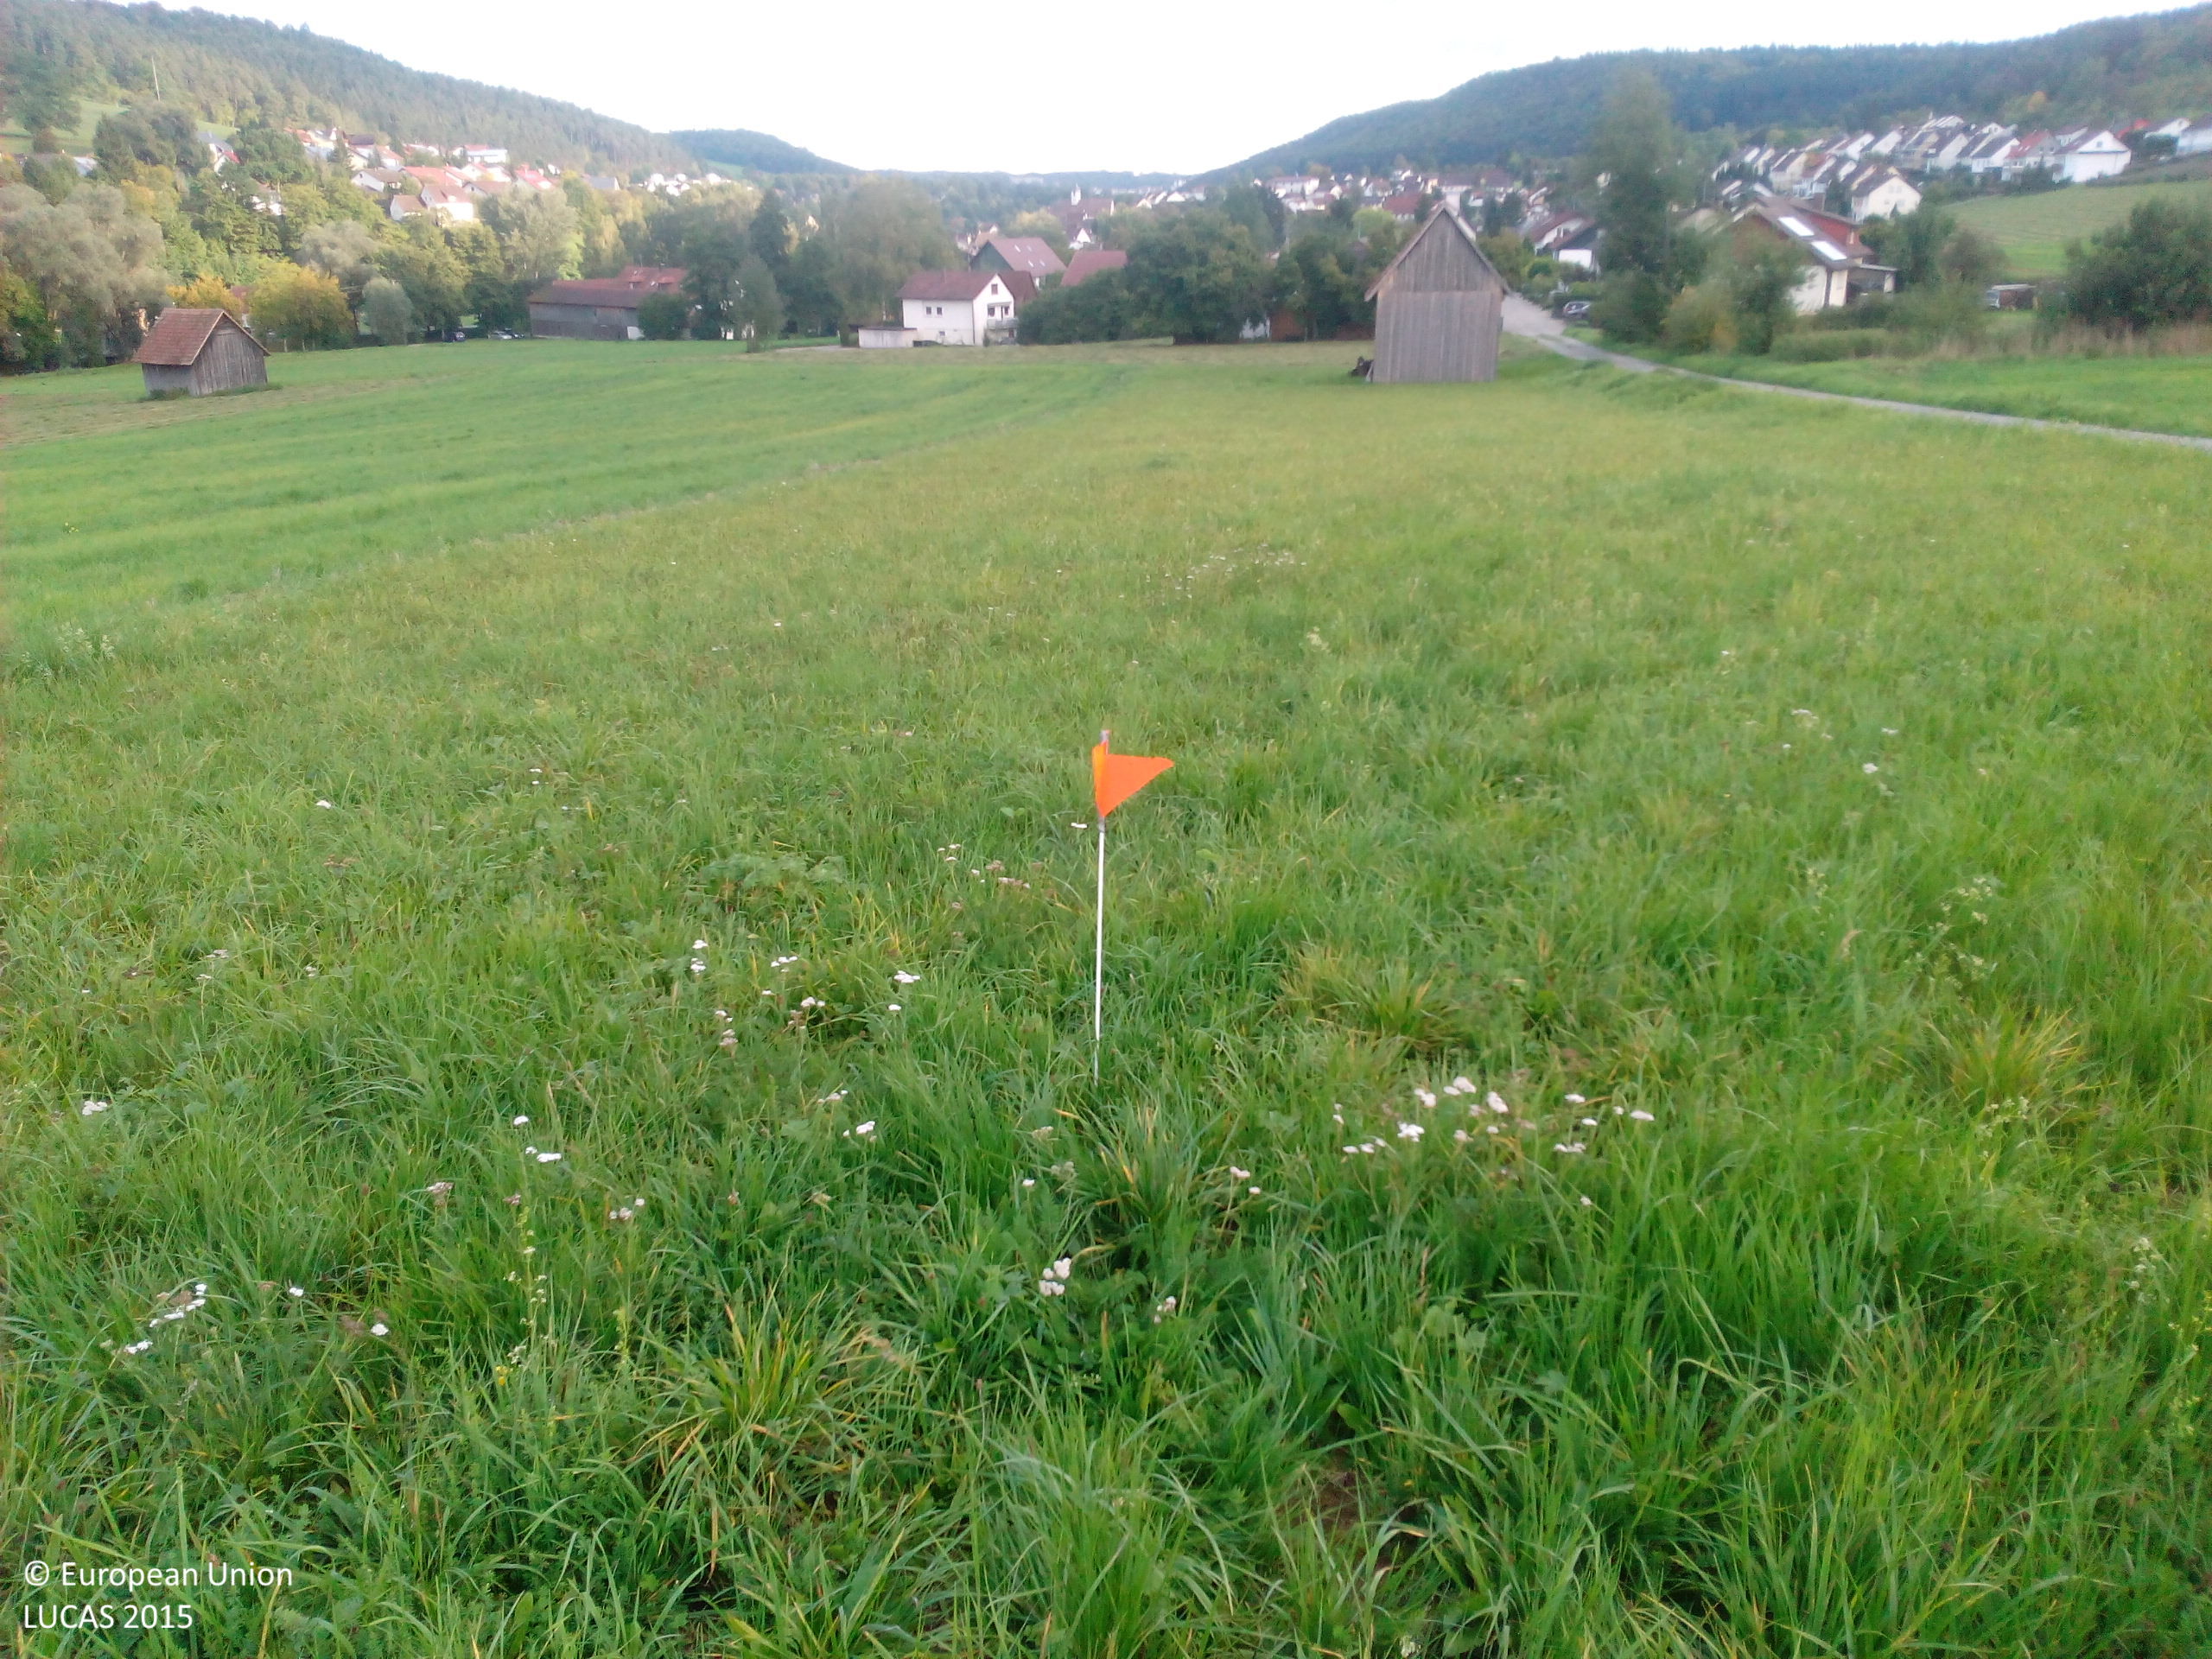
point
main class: Grassland
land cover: Grassland without tree/shrub cover
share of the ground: > 75 %
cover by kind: herbaceous plants 100 %
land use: Agriculture (excluding fallow land and kitchen gardens)
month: September
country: DE
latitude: 48.5756
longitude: 8.6859
